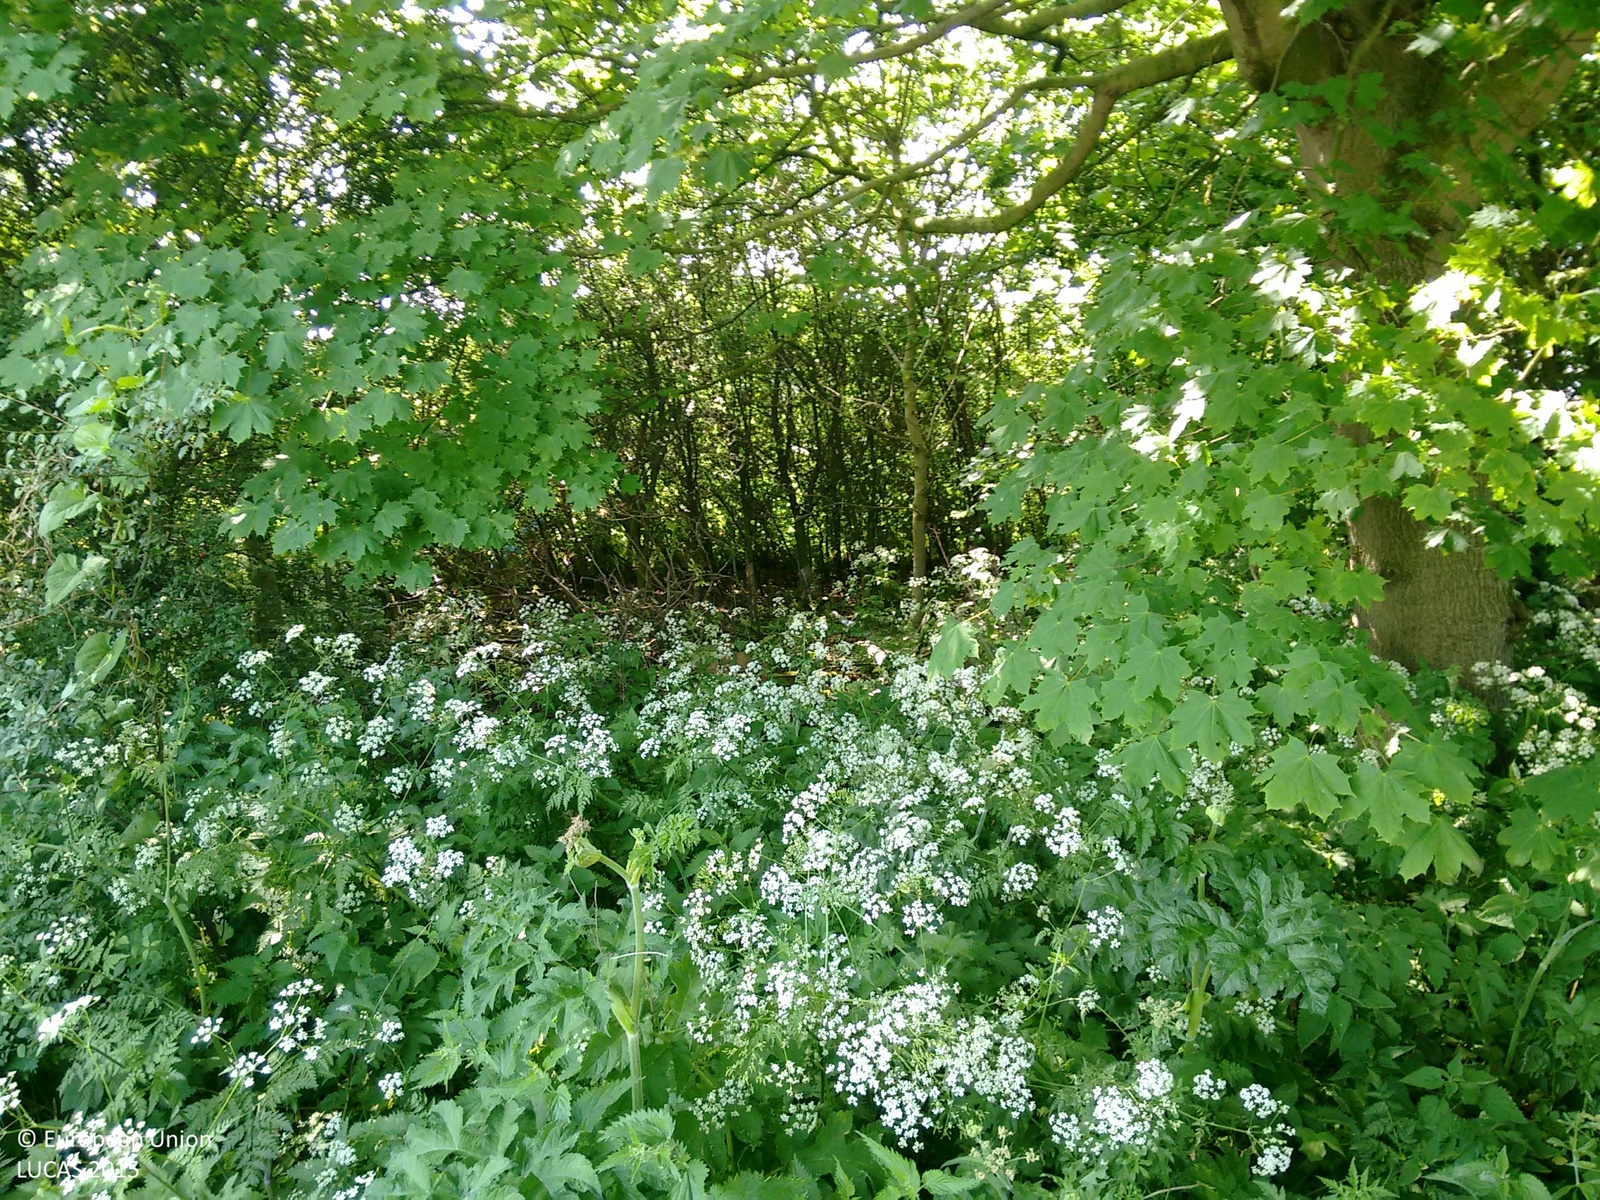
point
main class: Woodland
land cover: Broadleaved woodland
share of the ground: > 75 %
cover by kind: broadleaved forest trees 100 %
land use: Semi-natural and natural areas not in use
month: June
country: GB
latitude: 53.9533
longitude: -1.1845
